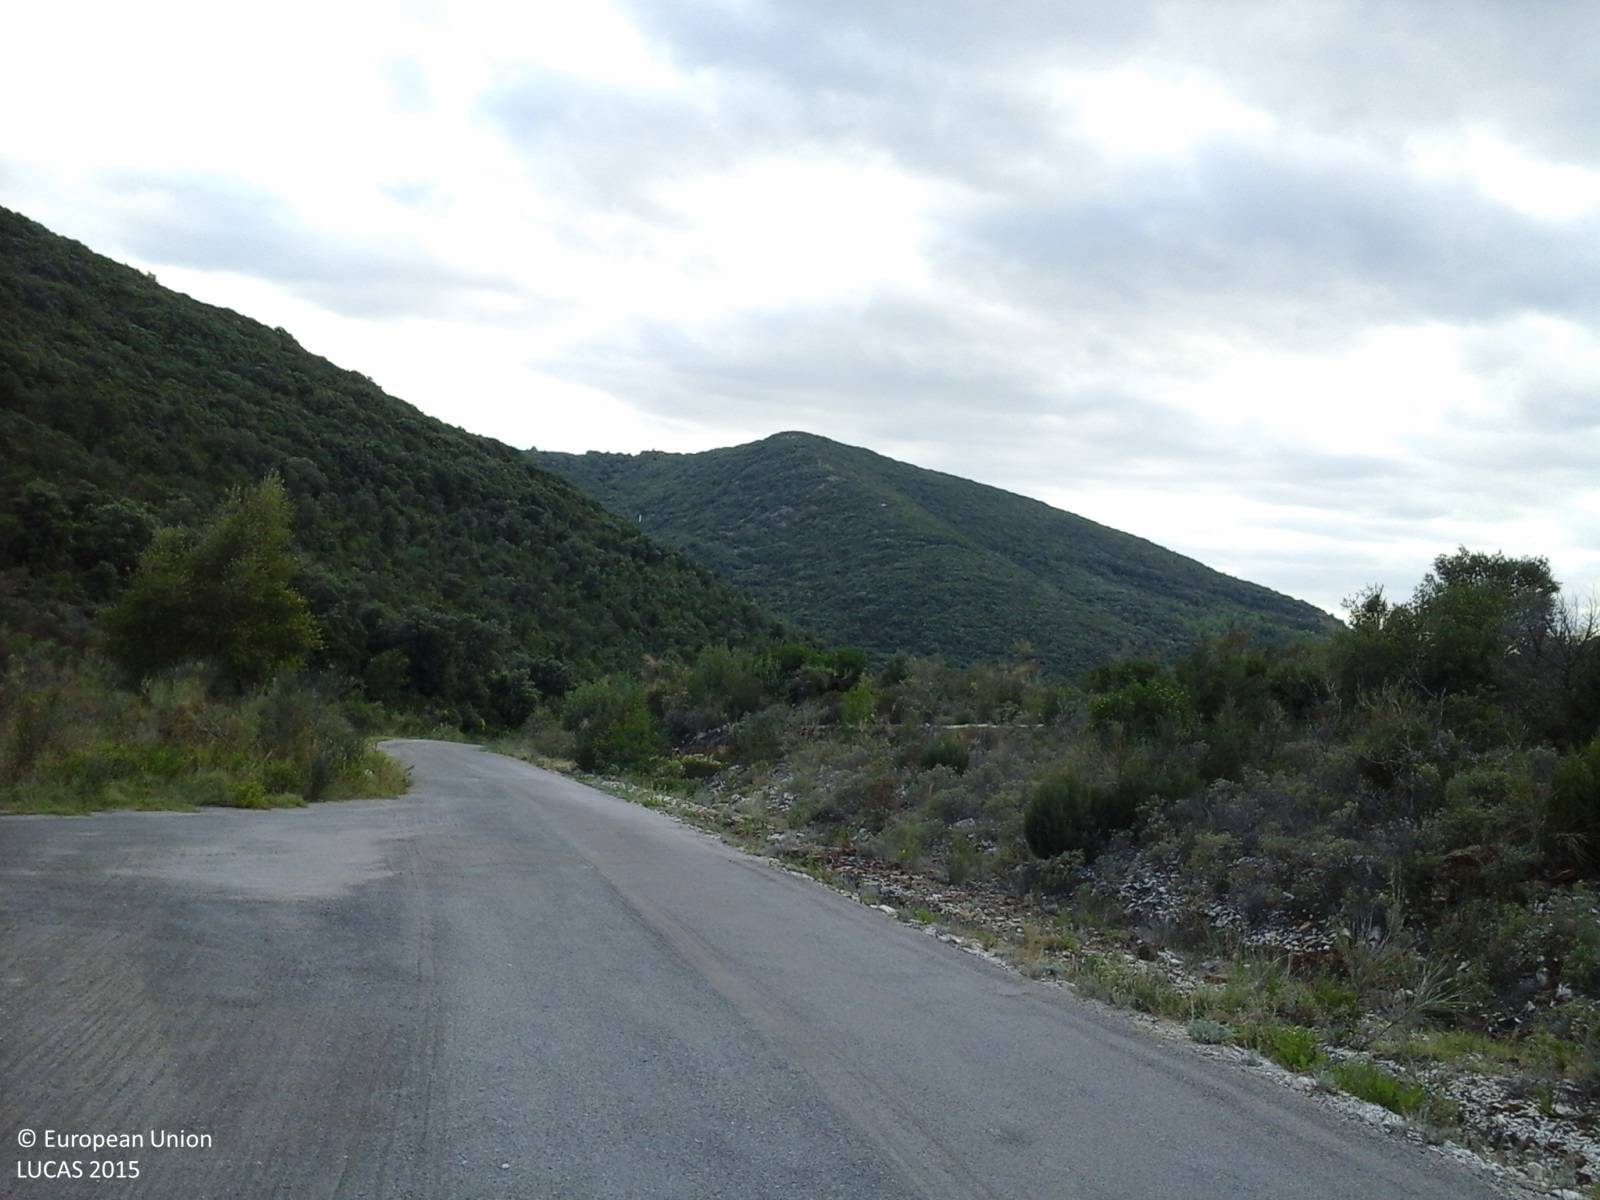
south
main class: Woodland
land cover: Broadleaved woodland
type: thermophilous deciduous forest
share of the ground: > 75 %
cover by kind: broadleaved forest trees 100 %
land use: Forestry
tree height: > 5 m
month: September
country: IT
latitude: 43.0856
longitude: 10.6000
